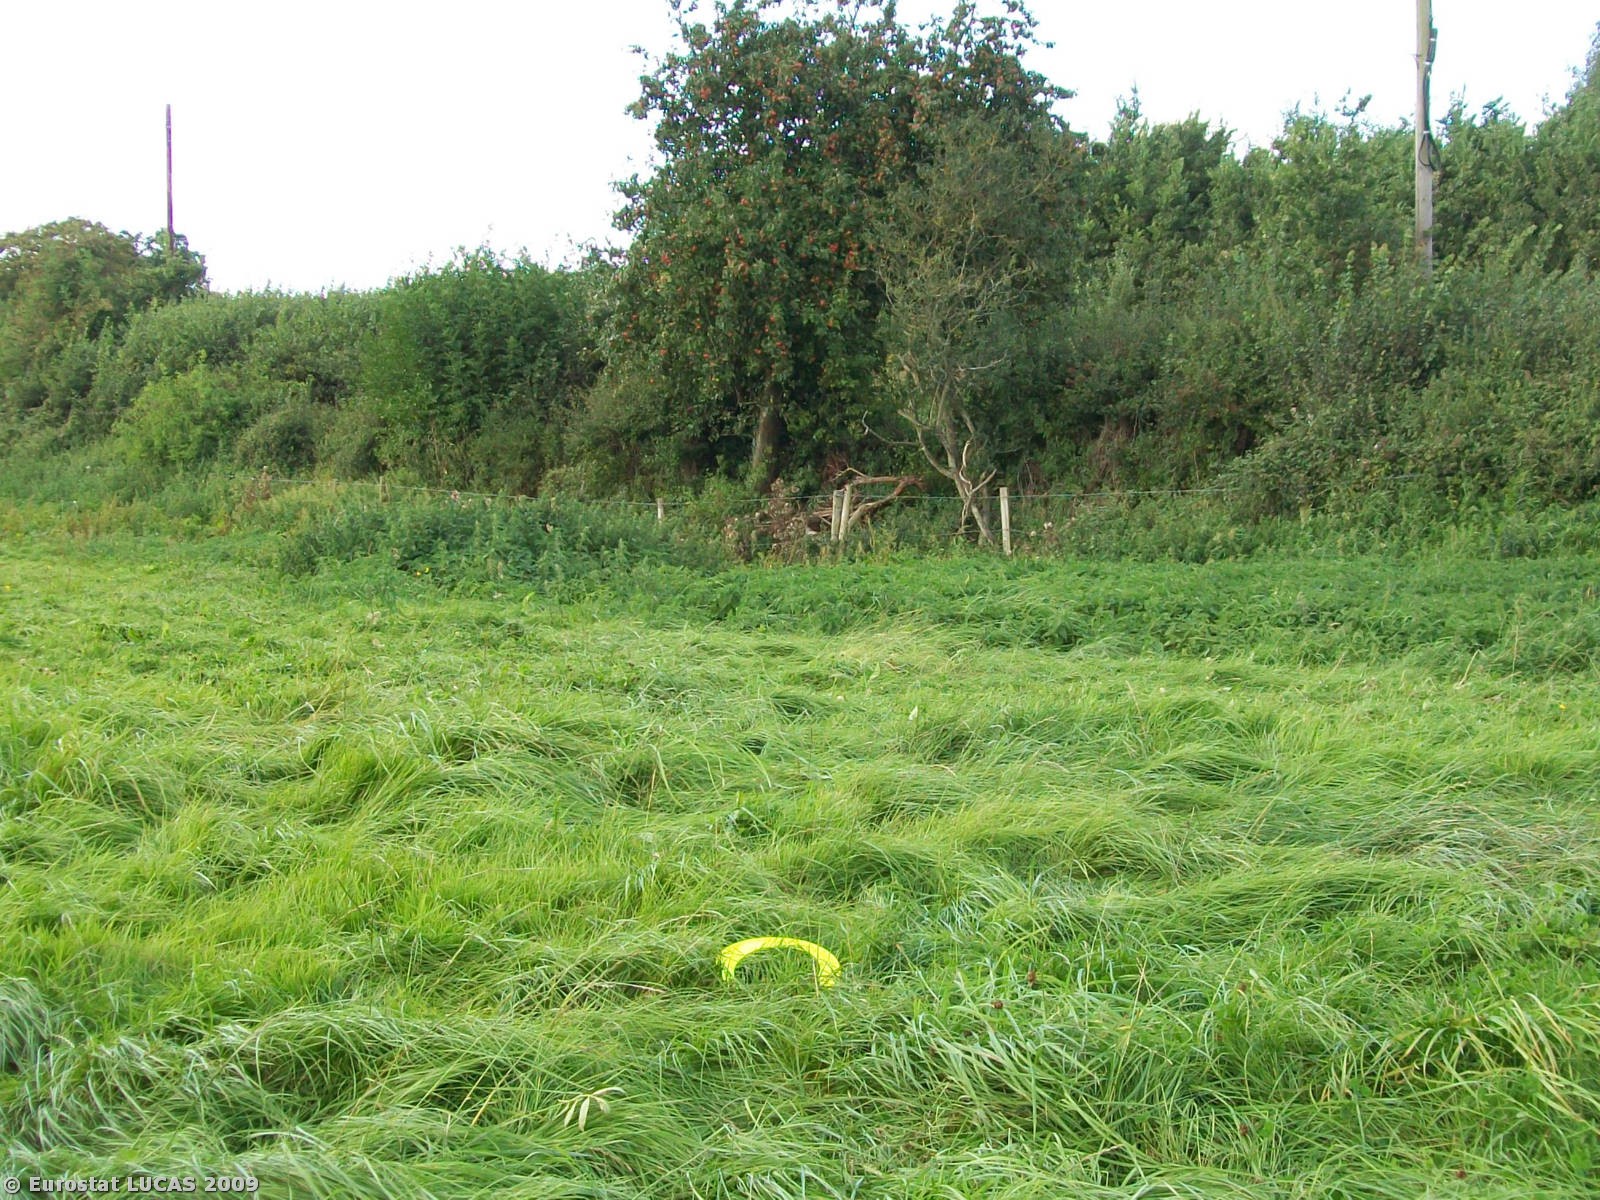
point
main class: Grassland
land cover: Grassland without tree/shrub cover
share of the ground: > 75 %
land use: Agriculture (excluding fallow land and kitchen gardens)
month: August
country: GB
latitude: 51.9854
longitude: -2.3388
